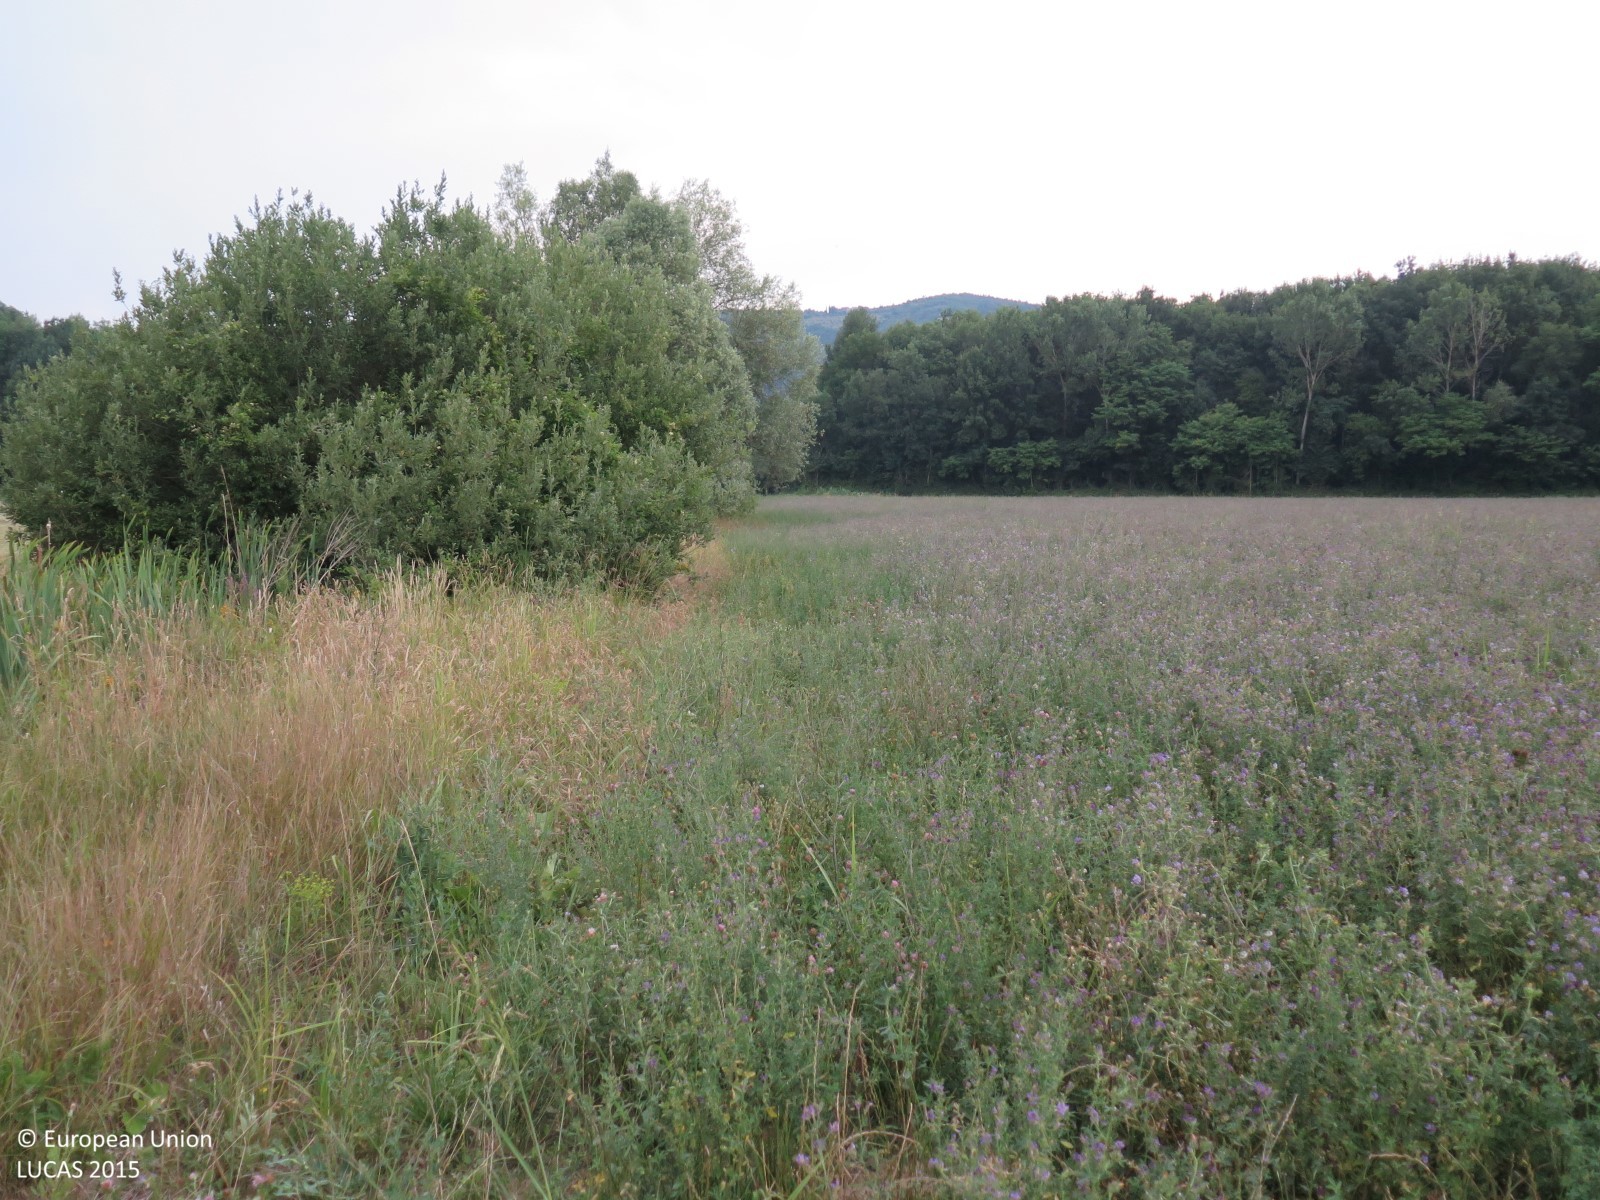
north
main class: Cropland
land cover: Lucerne
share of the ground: > 75 %
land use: Agriculture (excluding fallow land and kitchen gardens)
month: July
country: HR
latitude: 45.3454
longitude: 13.8111
